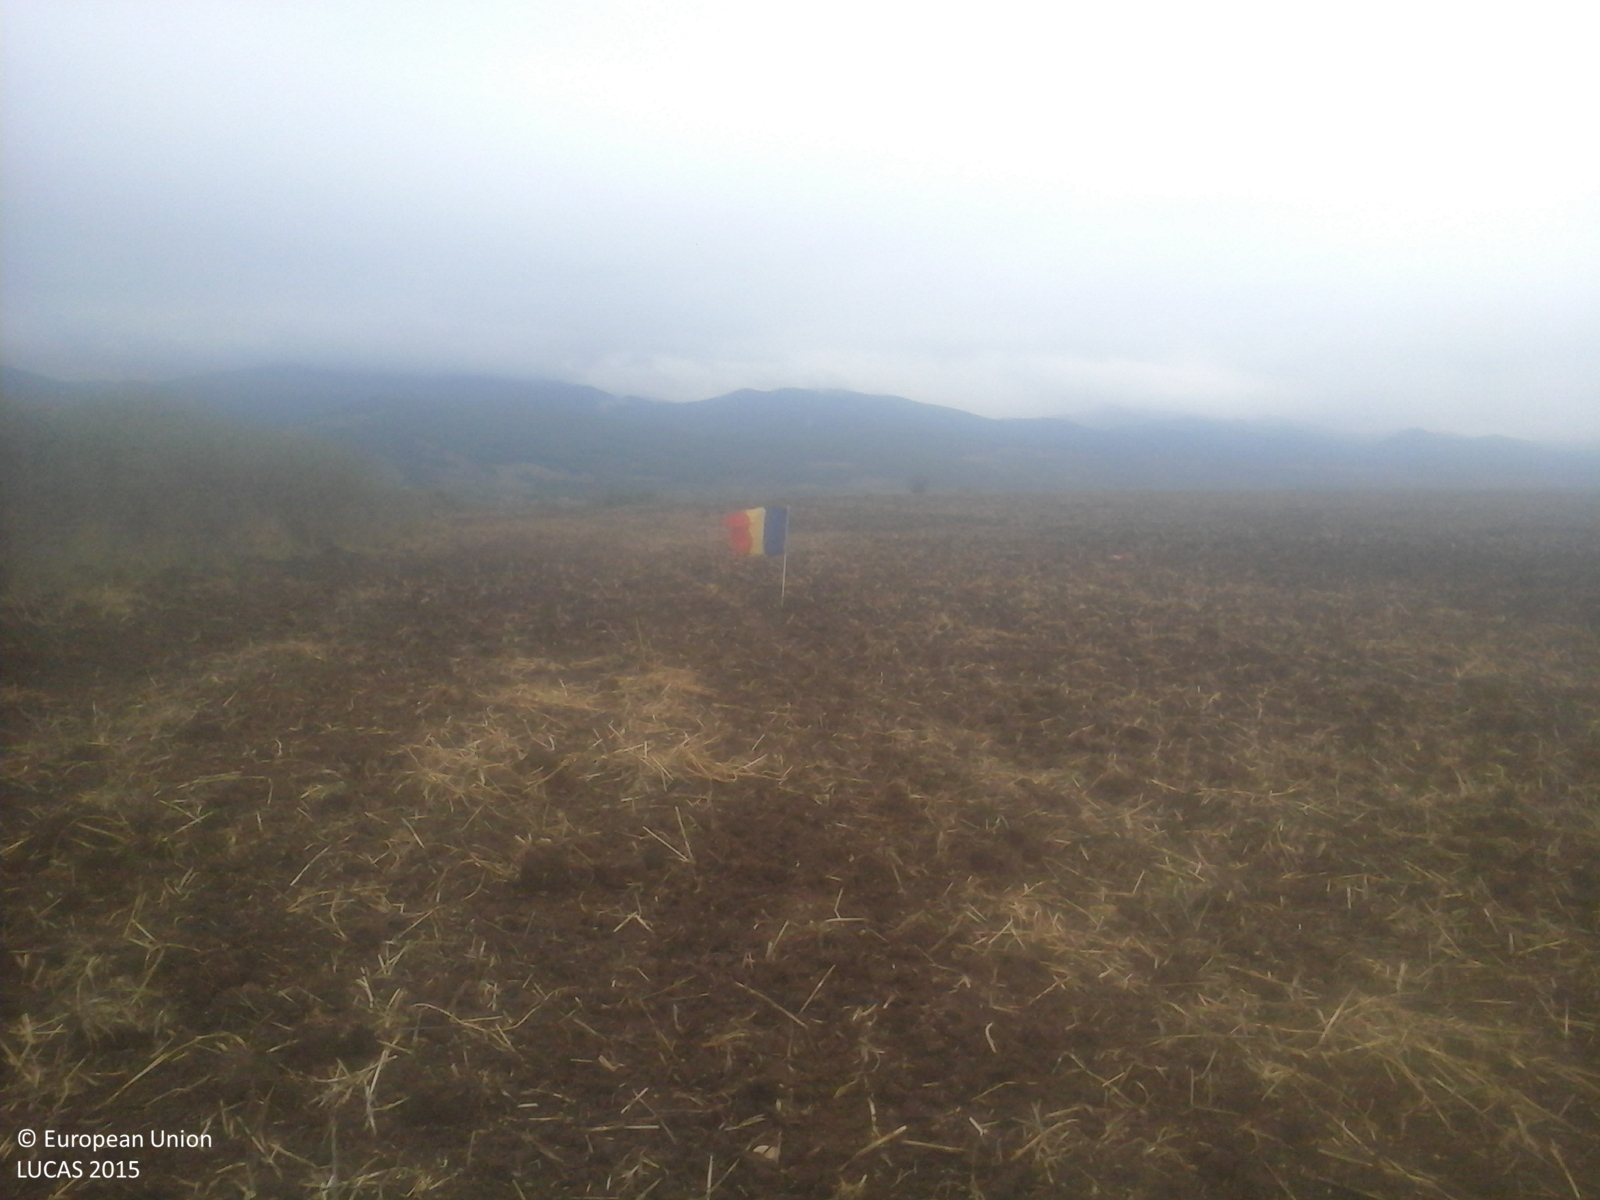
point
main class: Cropland
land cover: Common wheat
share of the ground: < 10 %
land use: Agriculture (excluding fallow land and kitchen gardens)
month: September
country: RO
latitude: 45.9399
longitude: 23.4125
